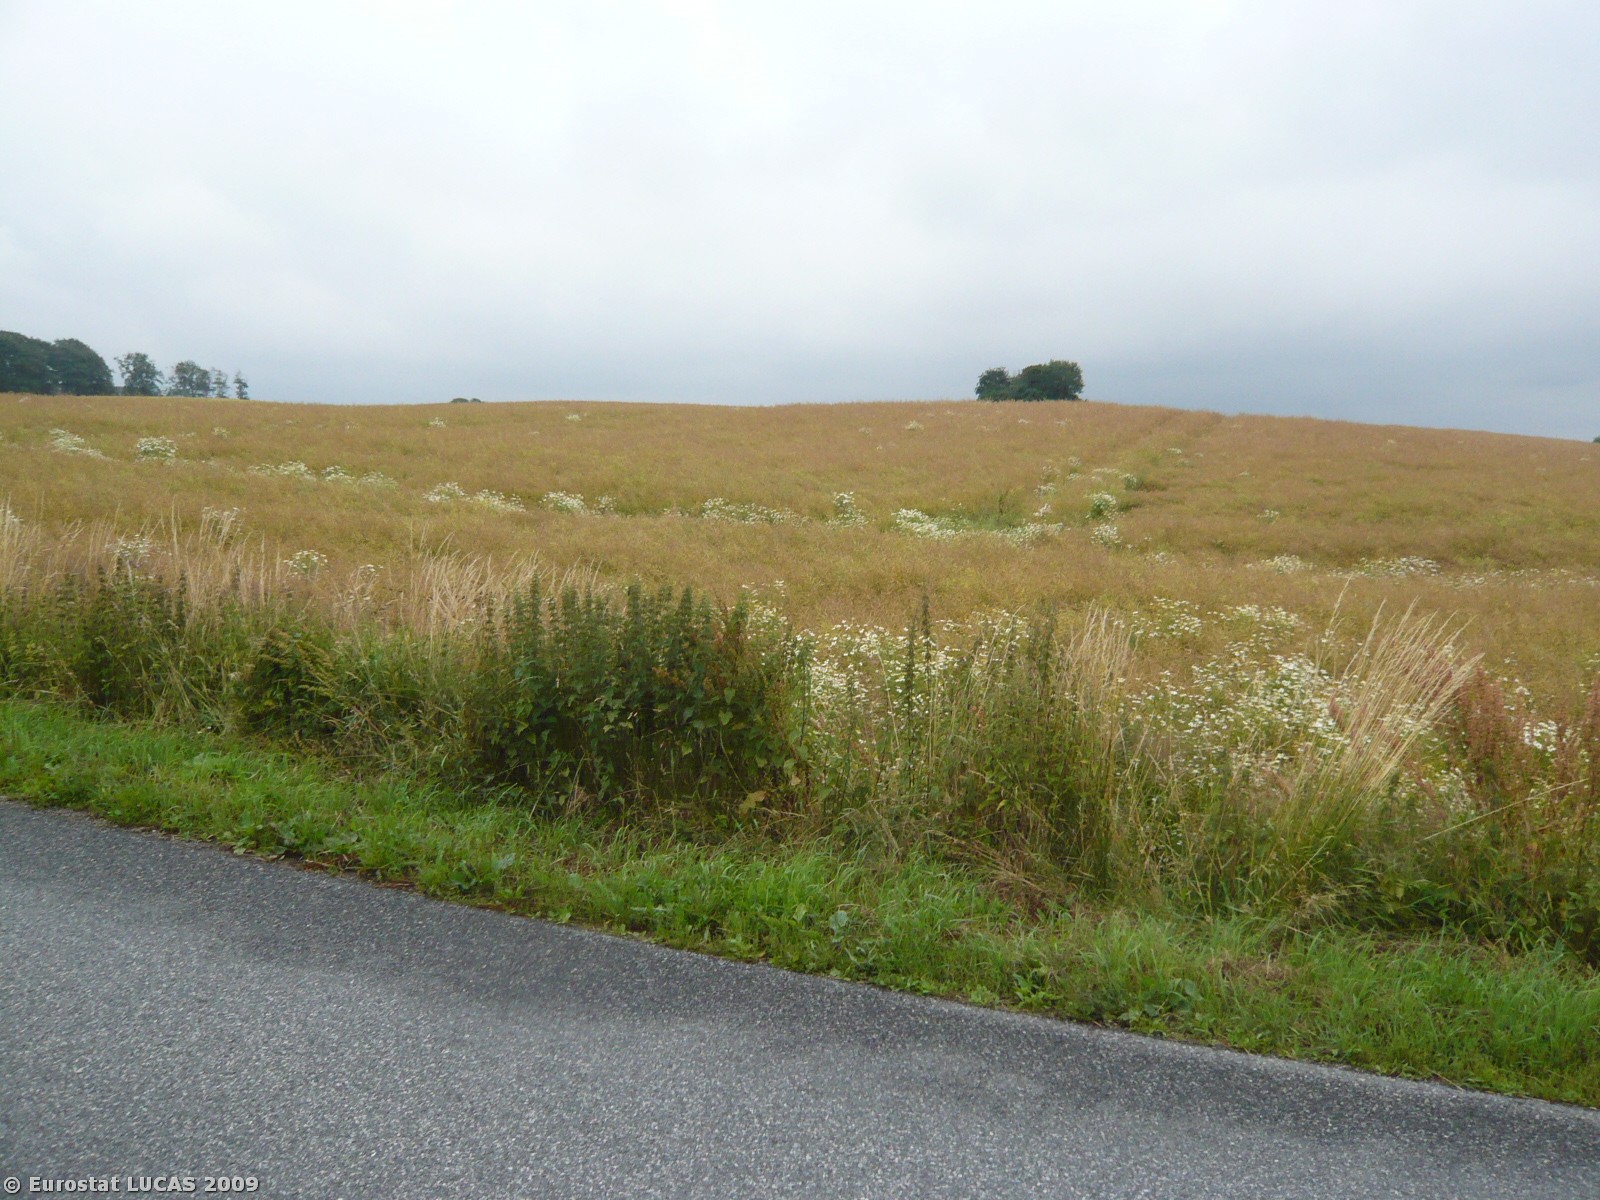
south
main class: Cropland
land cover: Rape and turnip rape
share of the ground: > 75 %
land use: Agriculture (excluding fallow land and kitchen gardens)
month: July
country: DK
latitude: 55.7423
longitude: 11.8938
